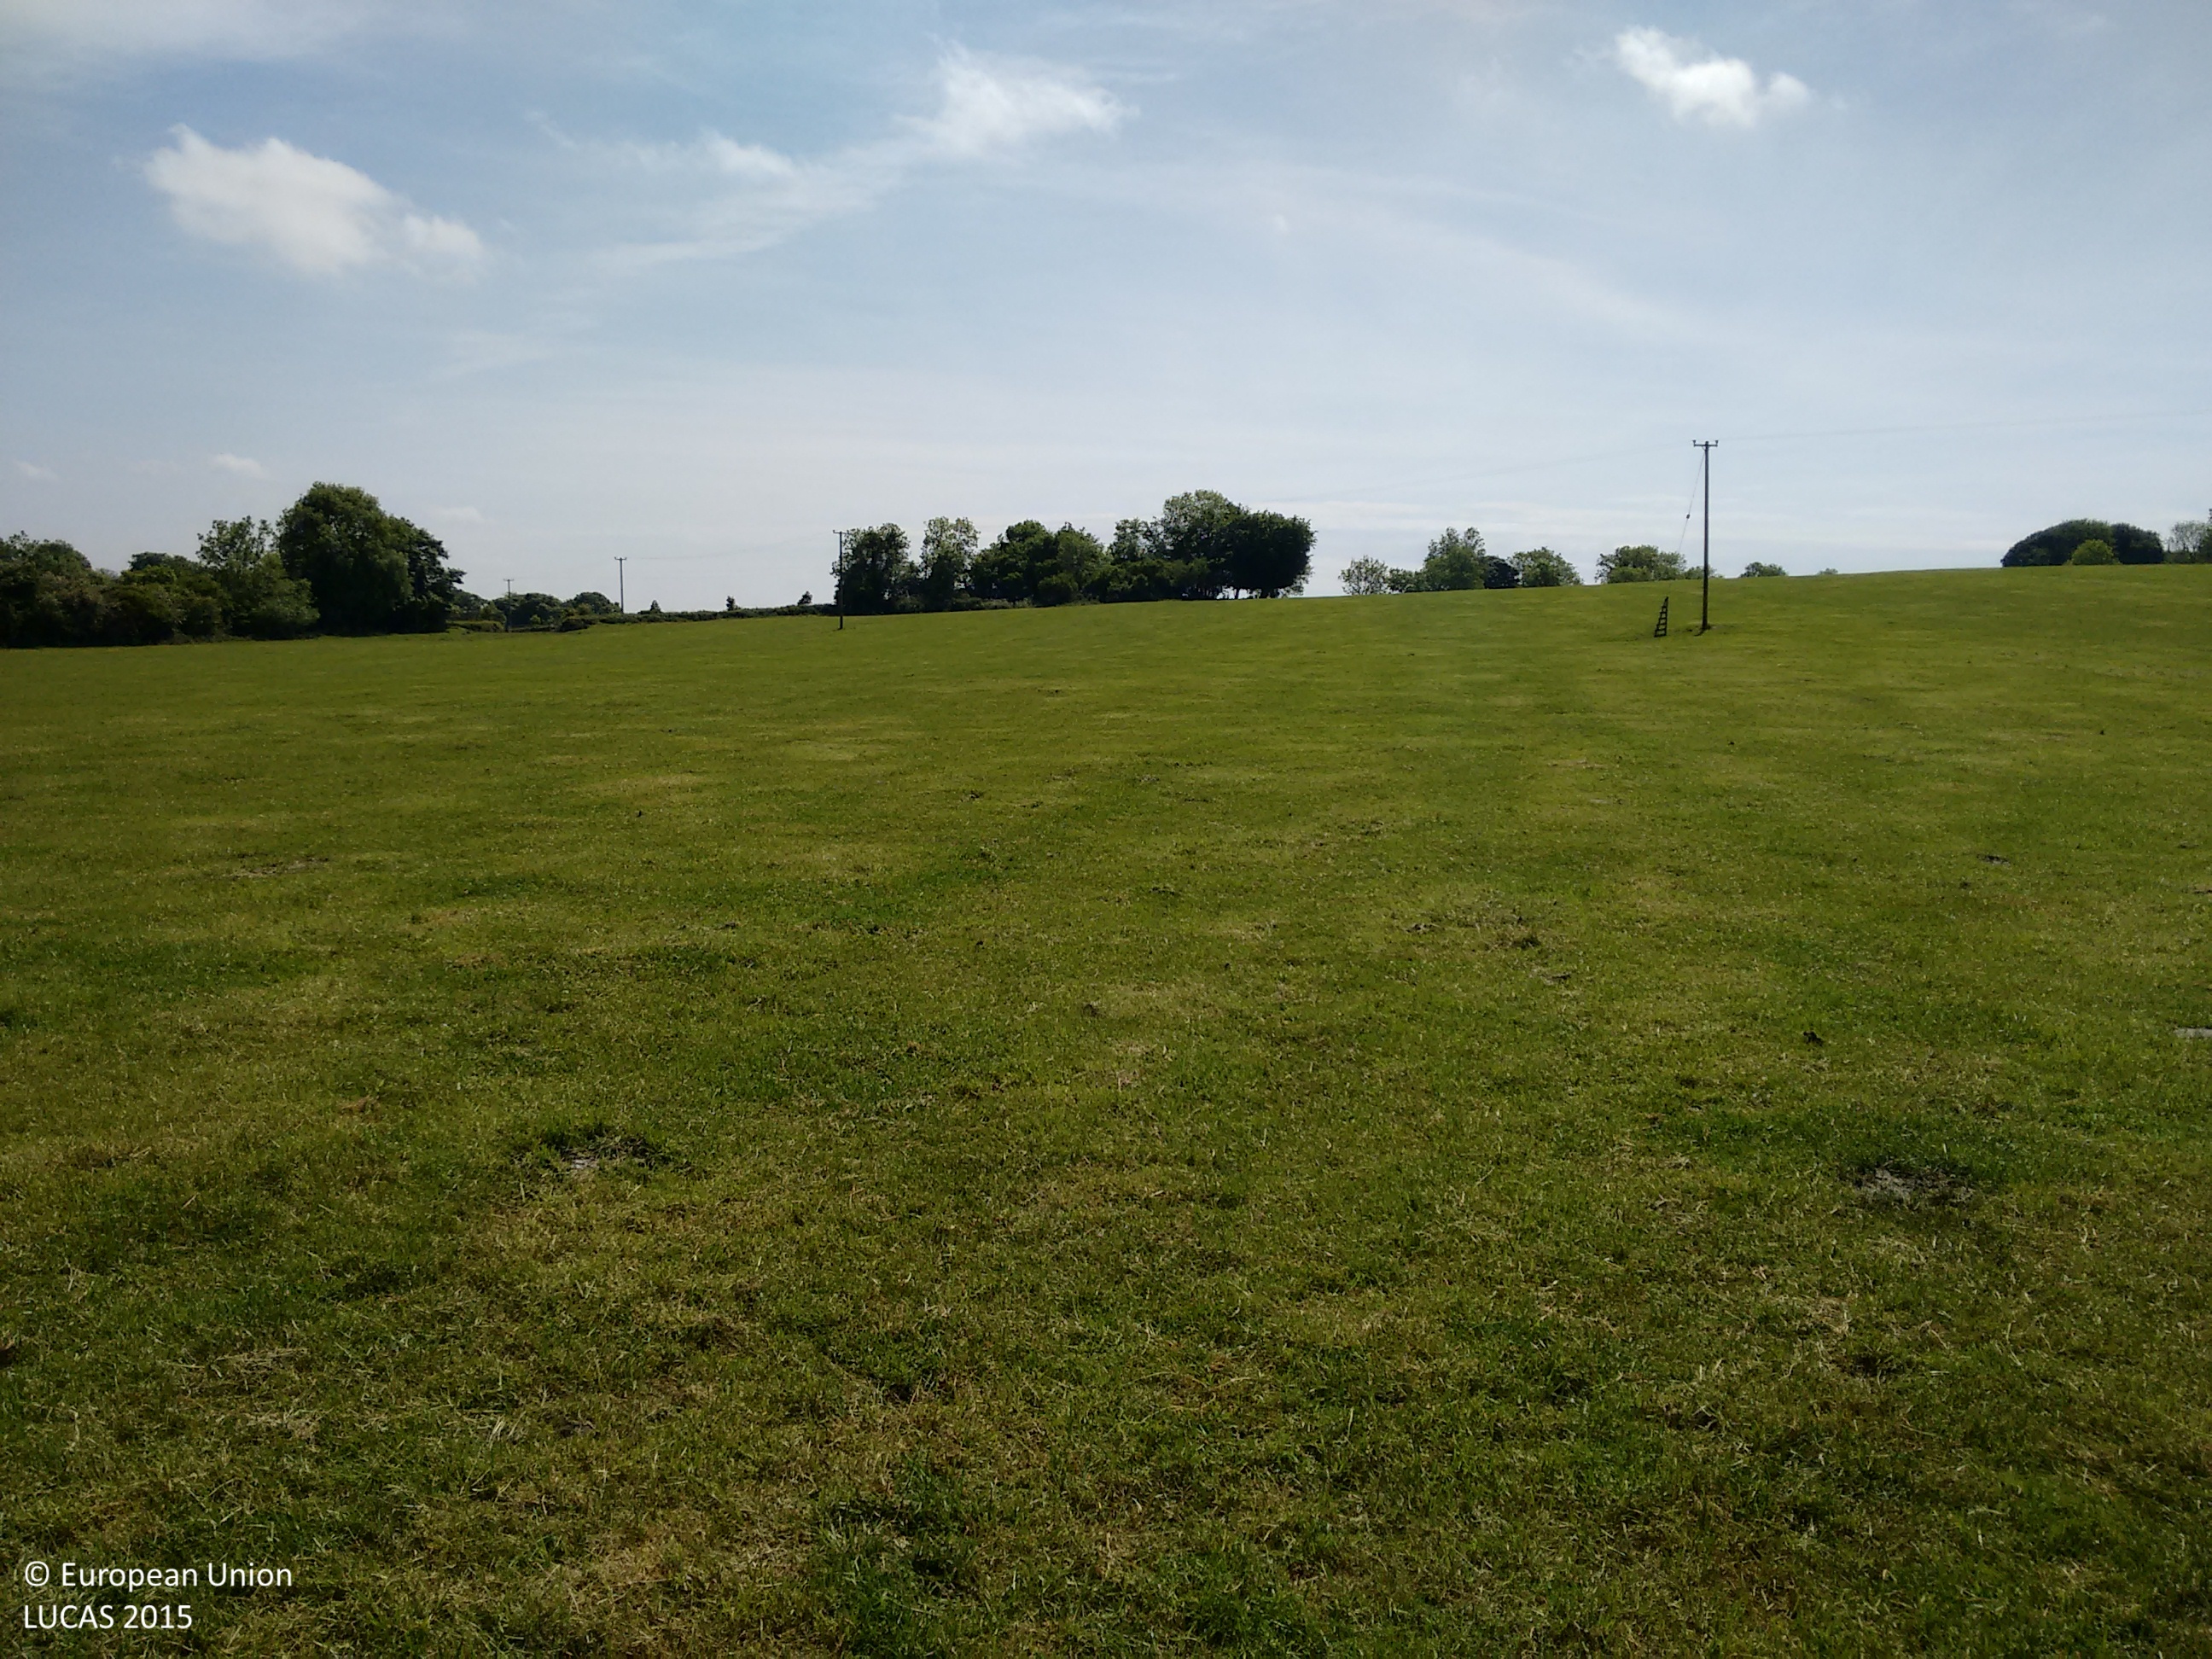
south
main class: Grassland
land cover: Grassland without tree/shrub cover
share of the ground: > 75 %
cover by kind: herbaceous plants 90 %, unconsolidated bare surface 10 %
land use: Agriculture (excluding fallow land and kitchen gardens)
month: June
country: IE
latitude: 53.5850
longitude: -6.6101
